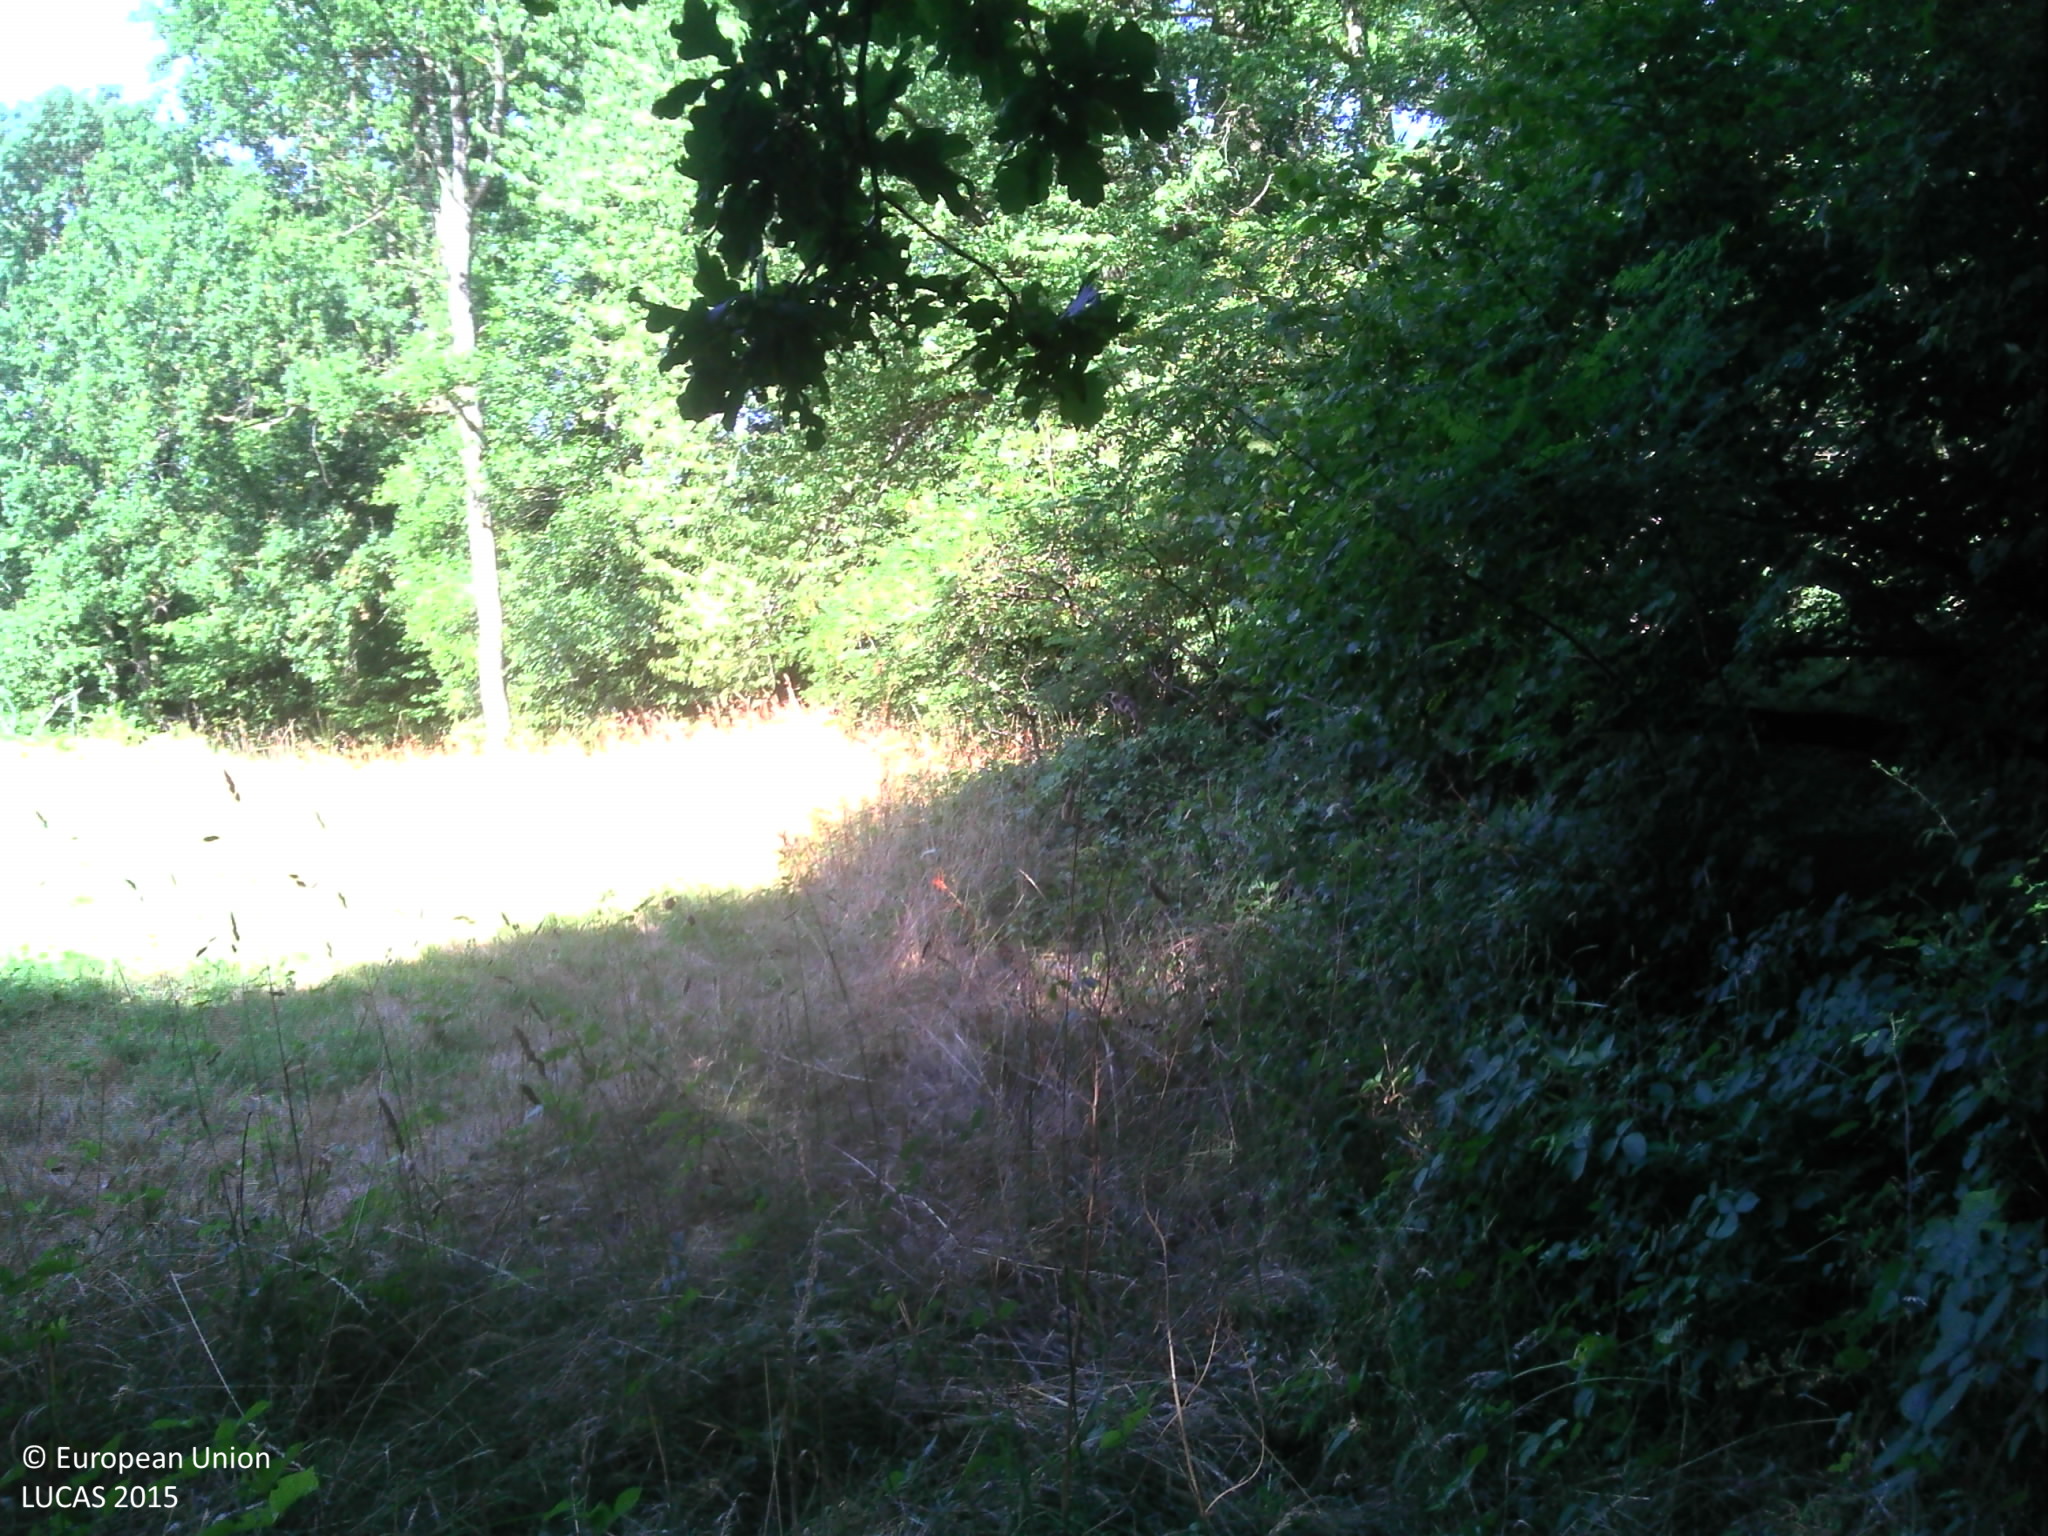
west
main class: Woodland
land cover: Broadleaved woodland
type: acidophilous oak and oak-birch forest
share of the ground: > 75 %
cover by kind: broadleaved forest trees 70 %, herbaceous plants 30 %
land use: Forestry
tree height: > 5 m
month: July
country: FR
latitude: 46.7438
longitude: 5.0934
